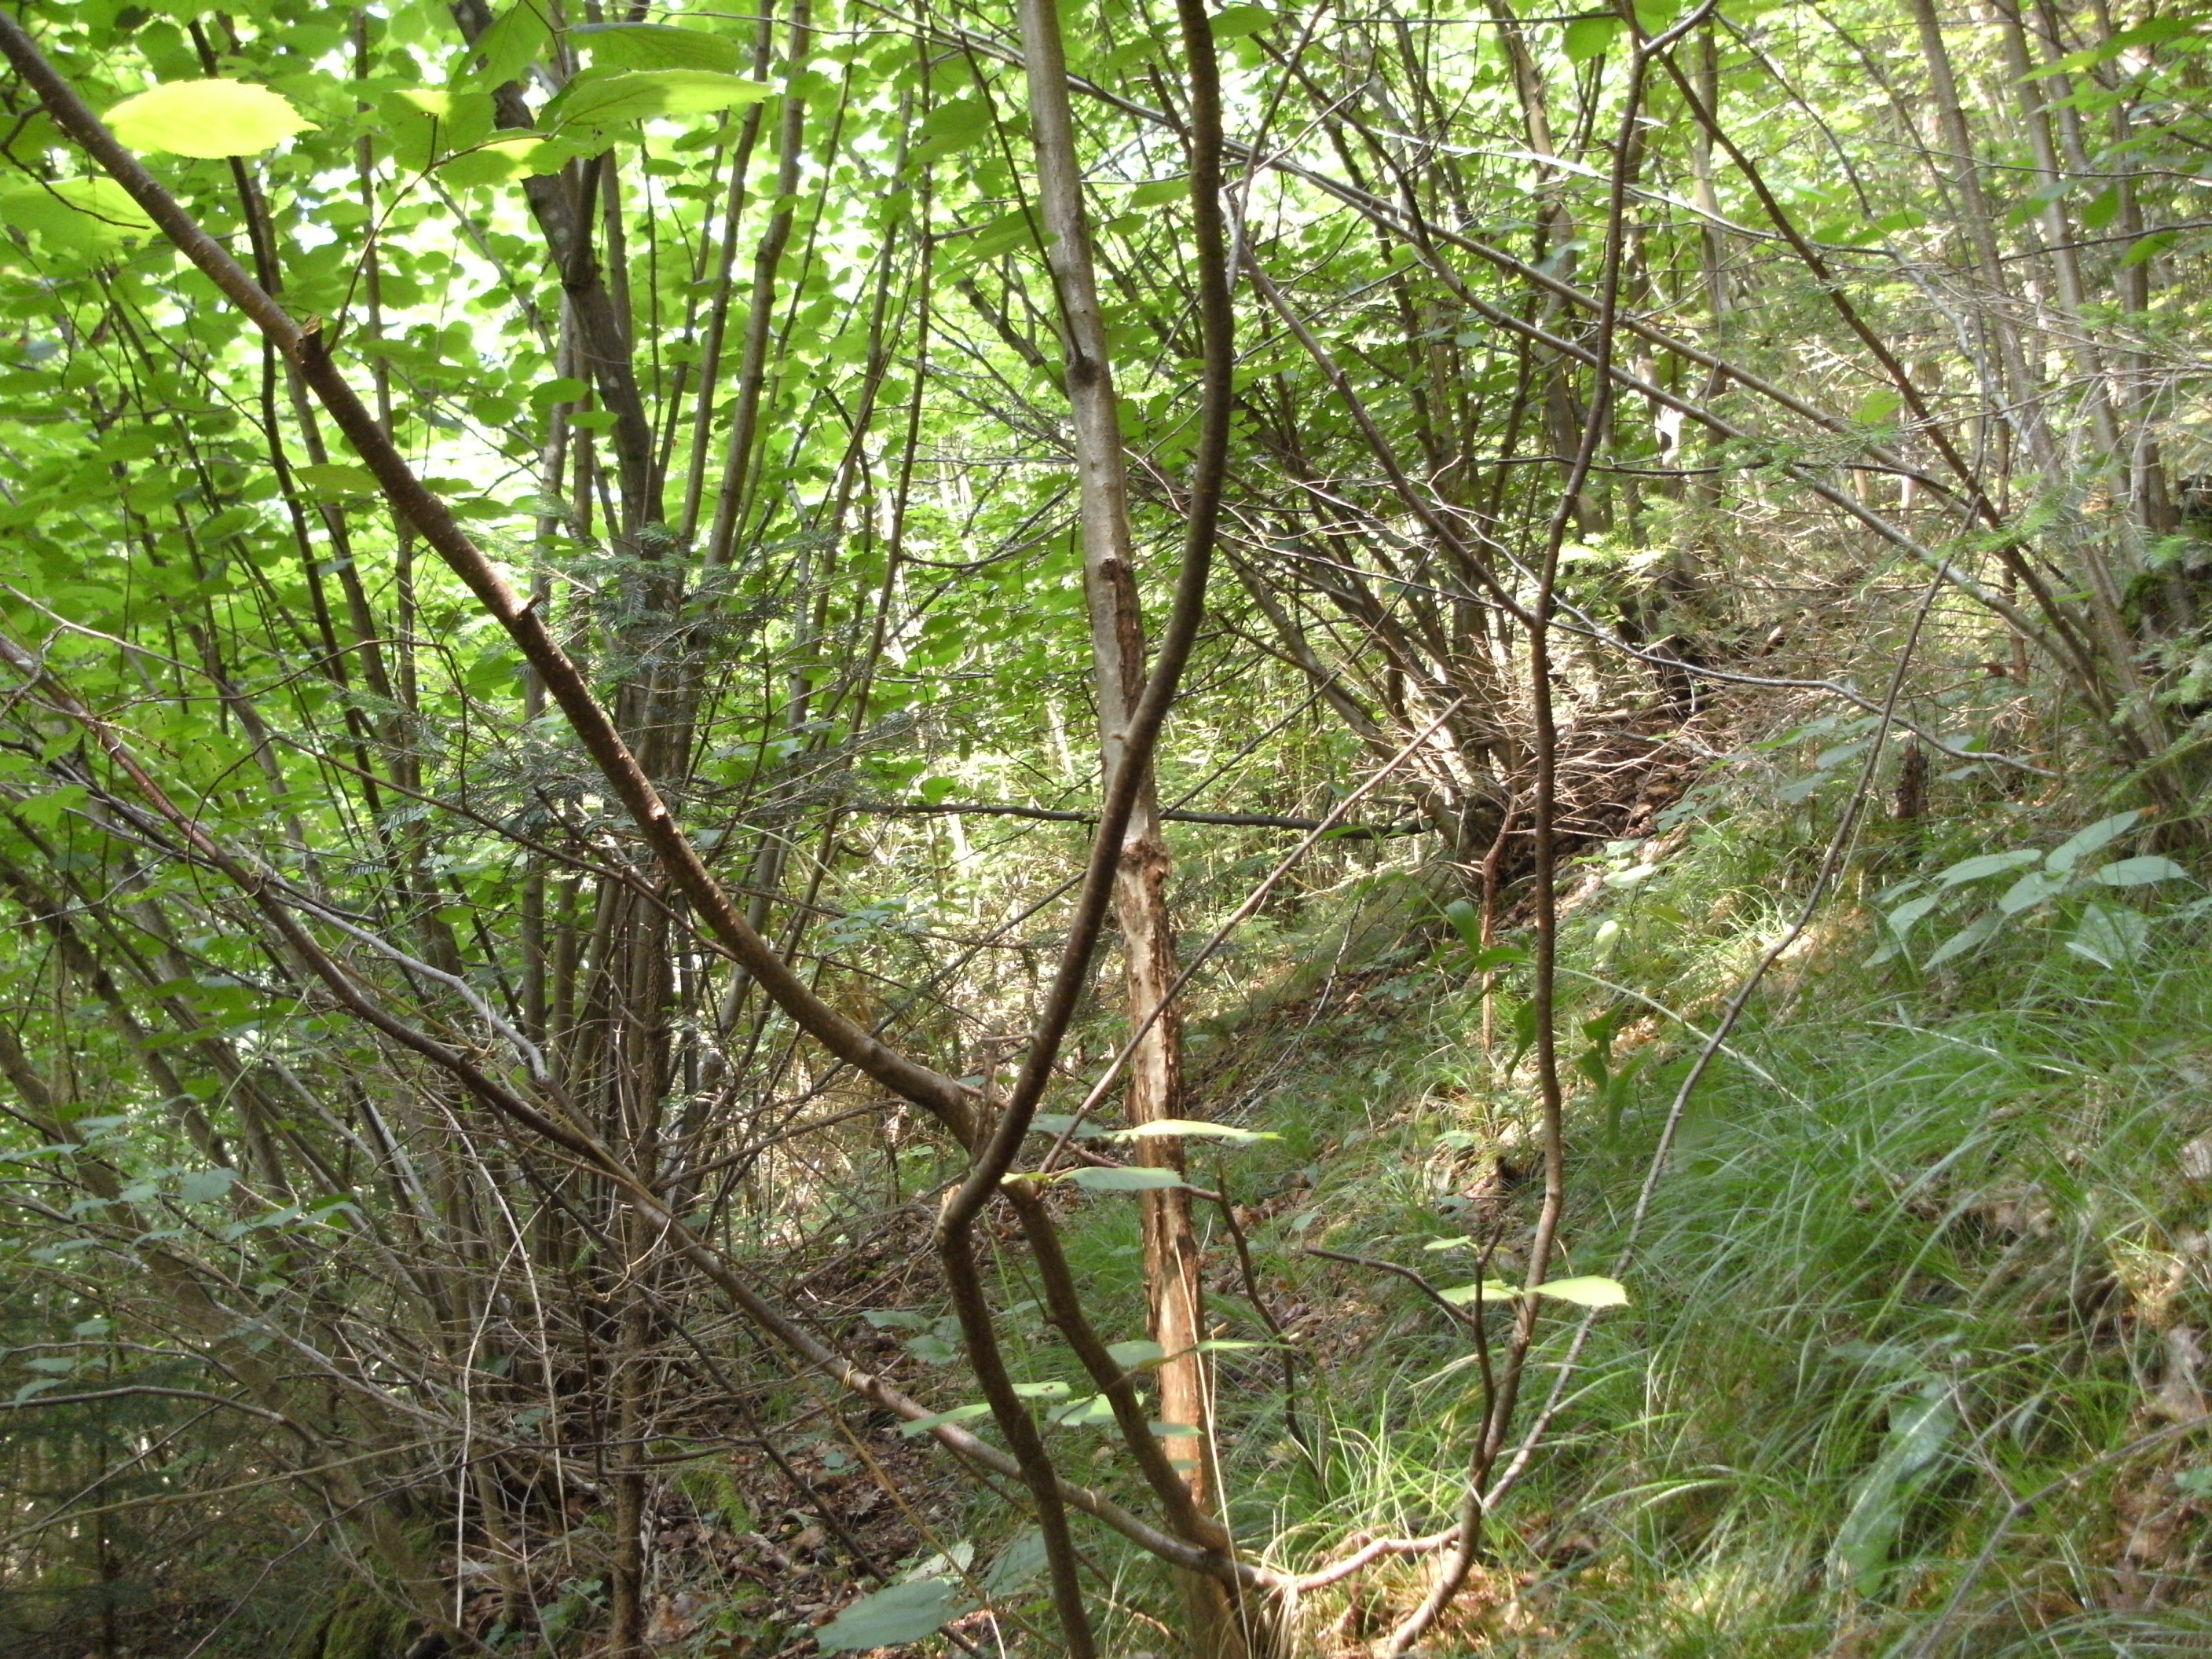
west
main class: Woodland
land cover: Spruce dominated coniferous woodland
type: hemiboreal forest and nemoral coniferous forest and mixed broadleaved-coniferous forest
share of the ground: 50 - 75 %
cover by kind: coniferous forest trees 60 %, shrubs 20 %, broadleaved forest trees 10 %, herbaceous plants 5 %, unconsolidated bare surface 5 %
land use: Forestry
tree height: > 5 m
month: July
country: AT
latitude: 46.6540
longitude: 14.8983
